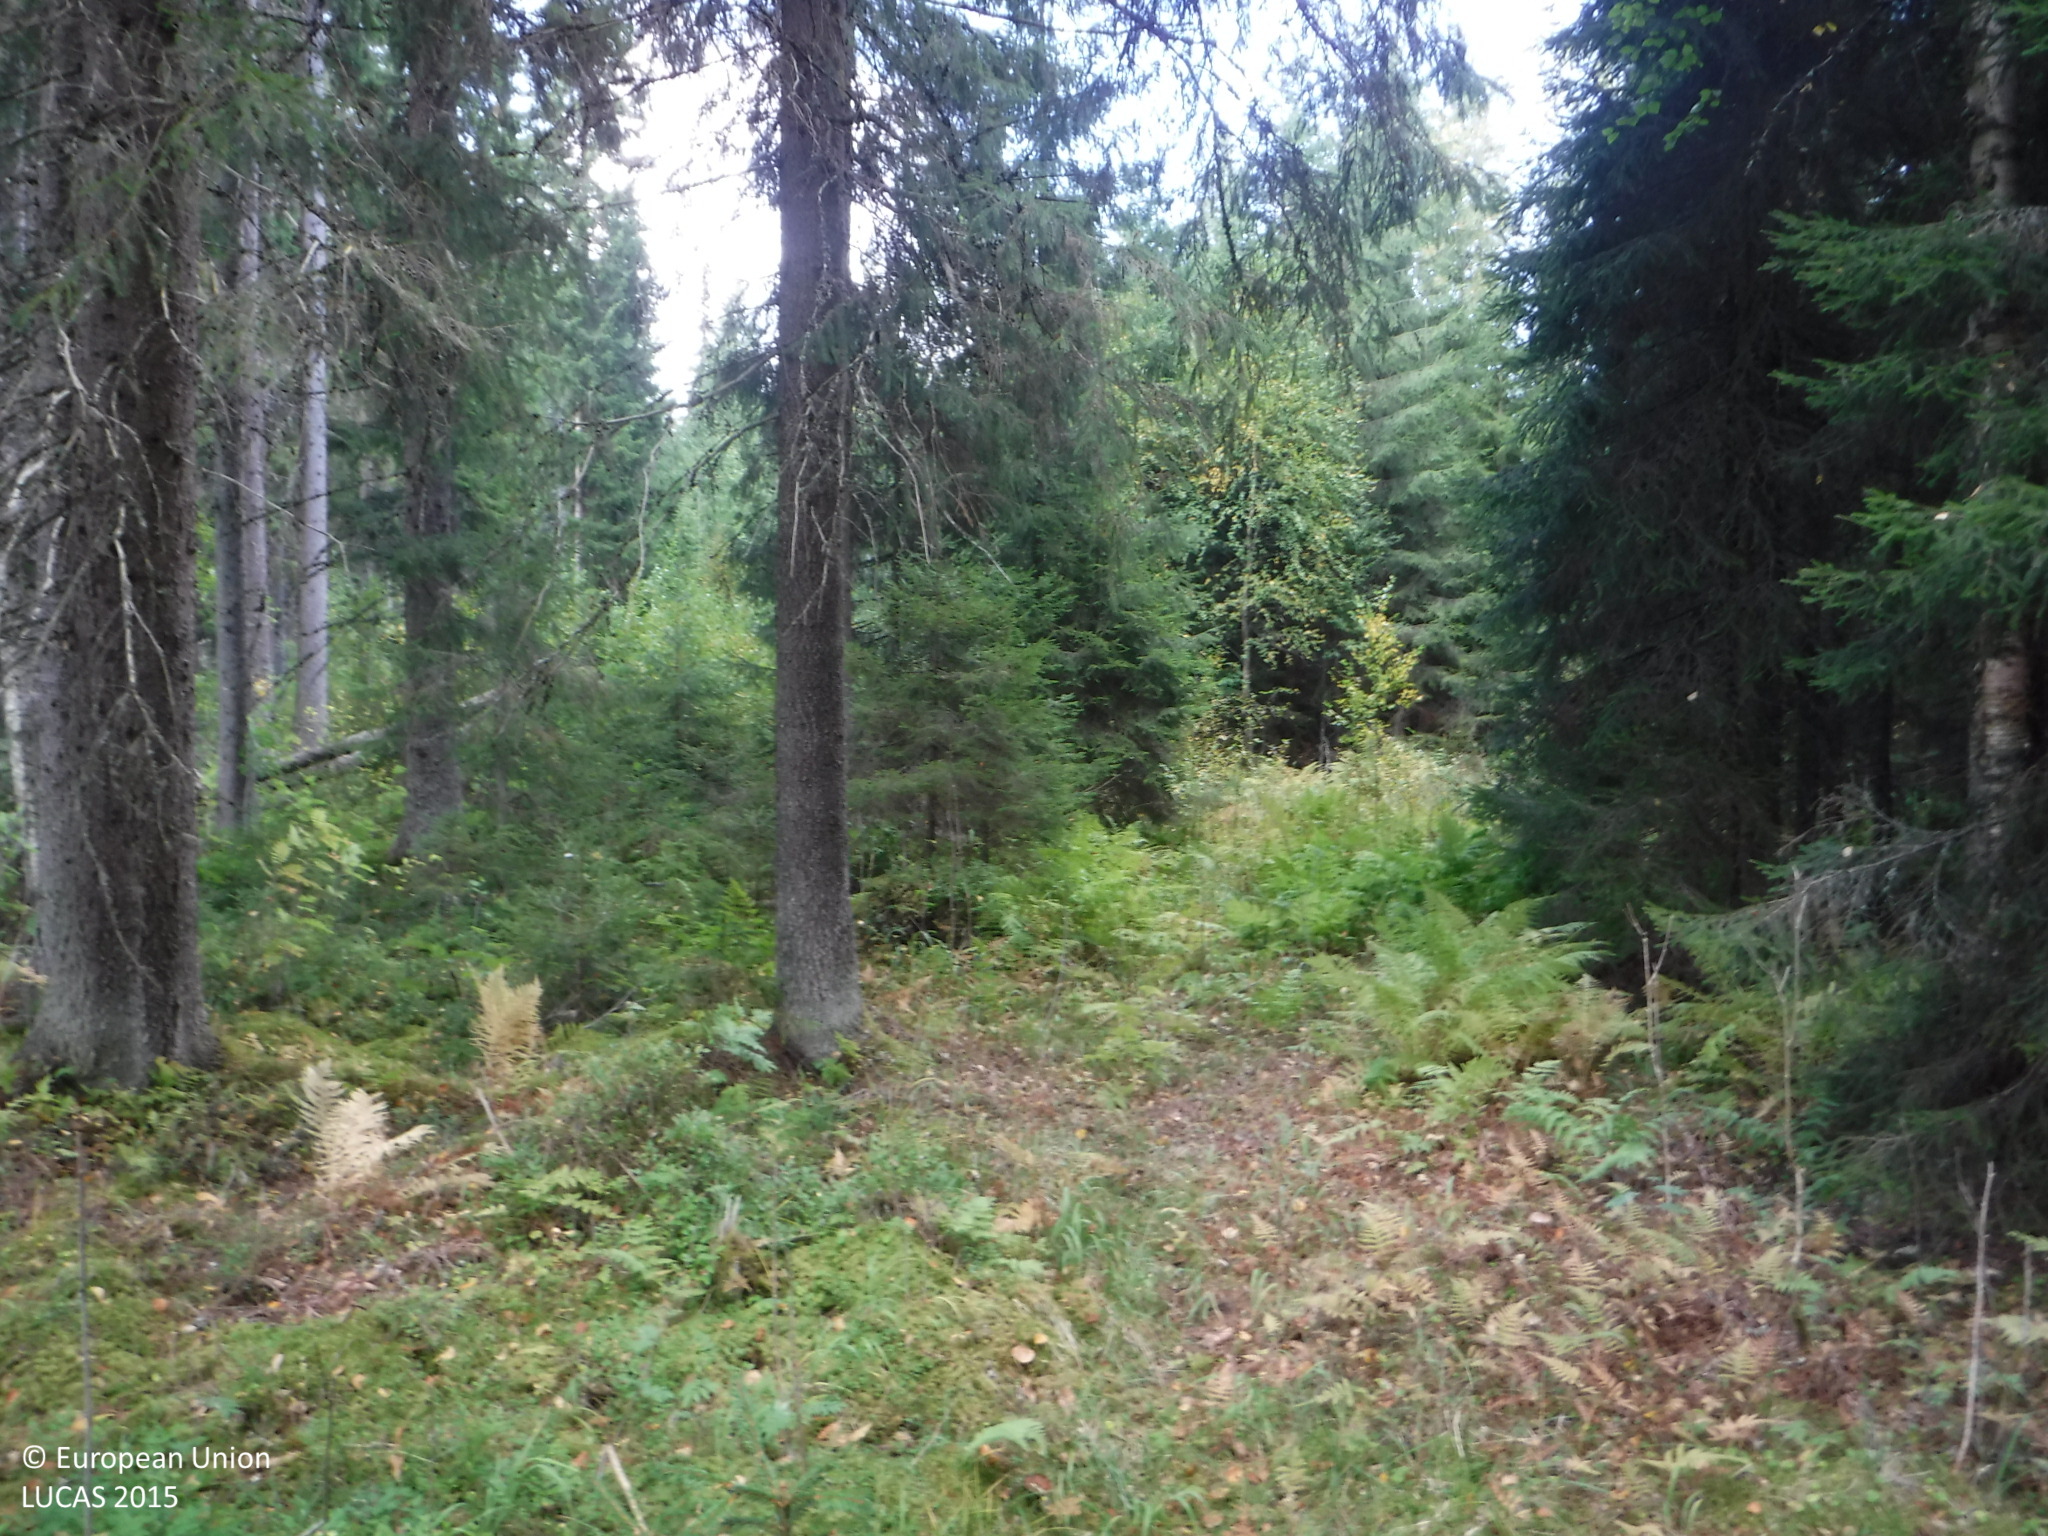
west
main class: Woodland
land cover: Spruce dominated coniferous woodland
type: boreal forest
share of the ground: 50 - 75 %
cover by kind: coniferous forest trees 60 %, herbaceous plants 20 %, broadleaved forest trees 10 %, lichens and mosses 10 %
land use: Forestry
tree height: > 5 m
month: September
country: FI
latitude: 61.7020
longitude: 22.1017
